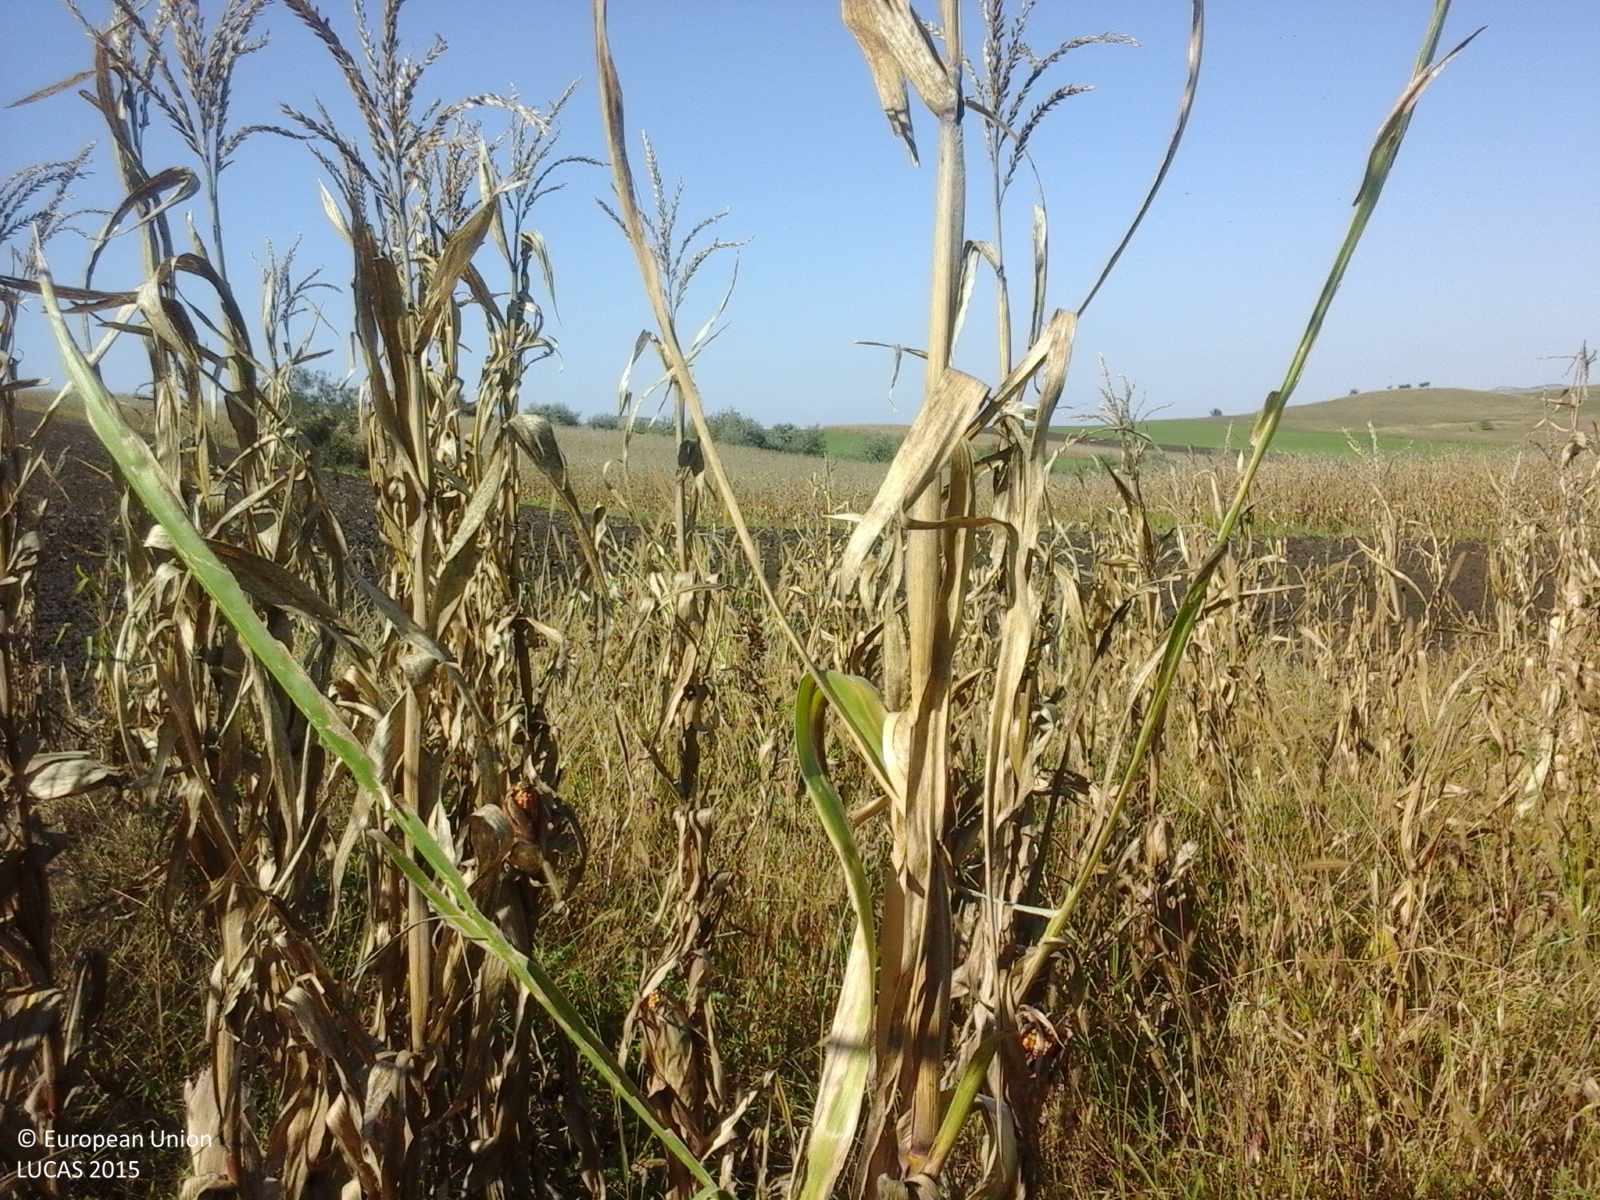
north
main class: Cropland
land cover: Maize
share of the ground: > 75 %
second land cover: Spontaneously vegetated surfaces
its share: > 75 %
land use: Agriculture (excluding fallow land and kitchen gardens)
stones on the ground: < 10 %
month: October
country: RO
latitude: 46.1479
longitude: 23.7813
